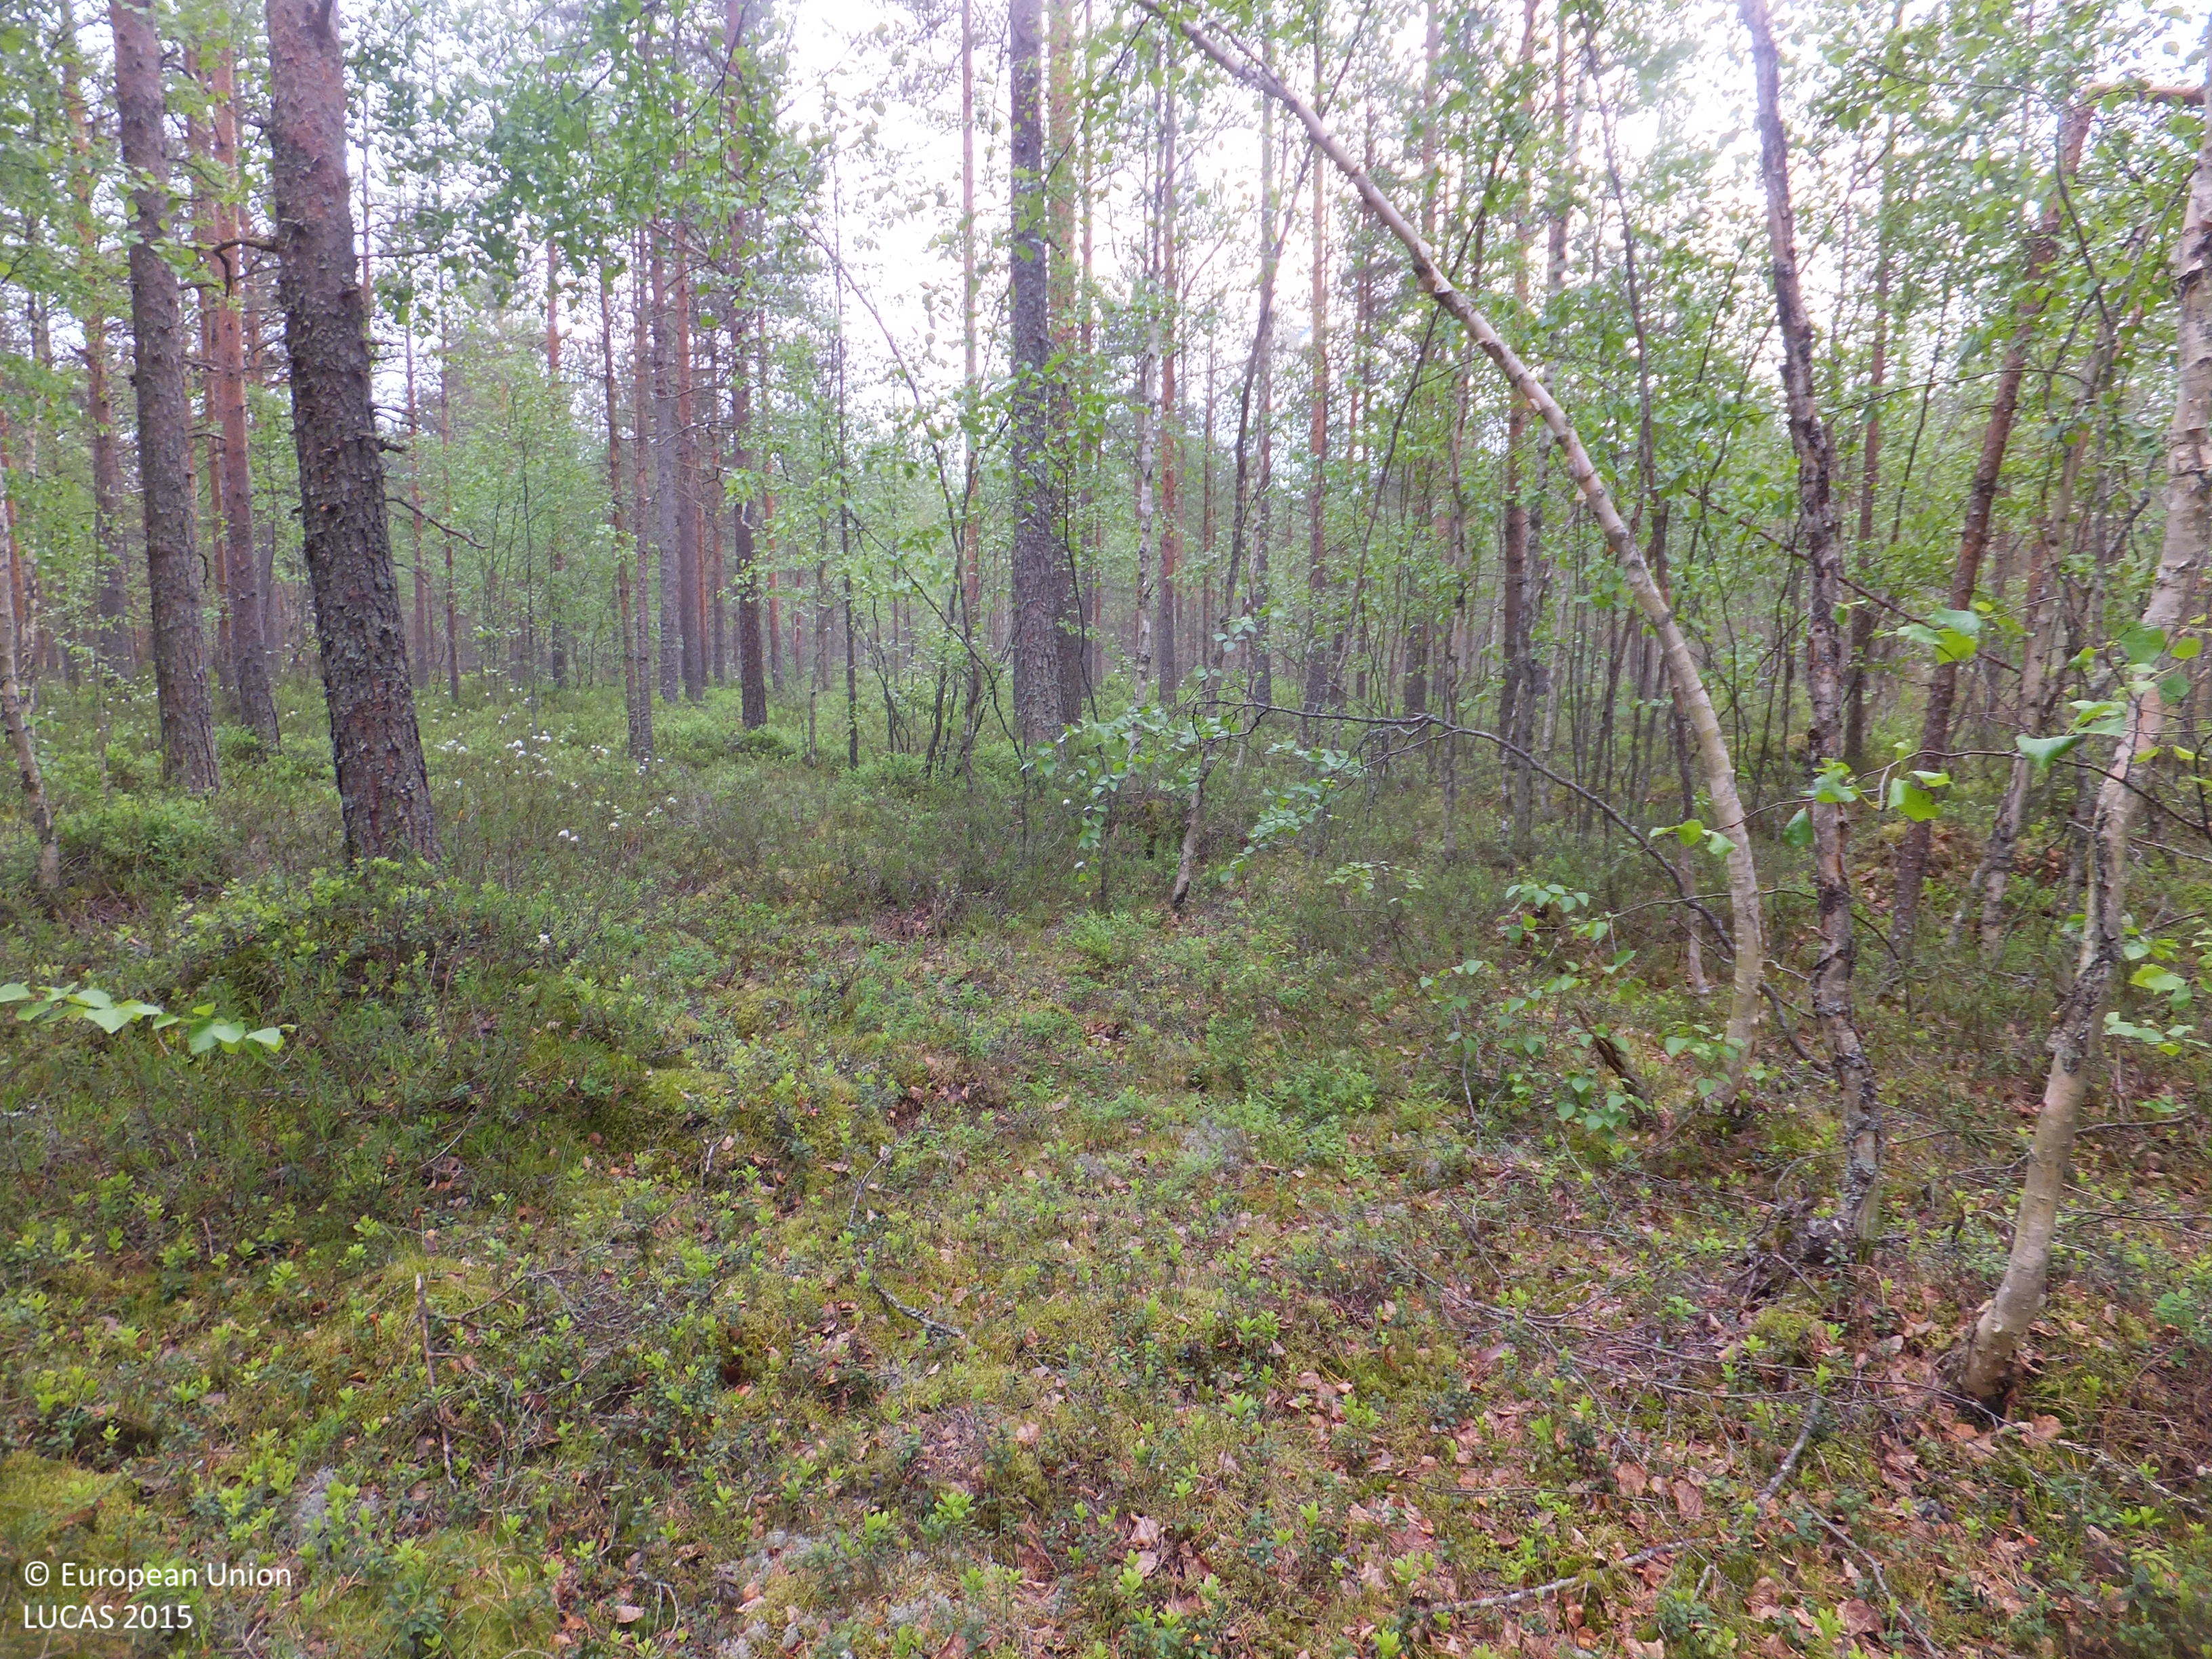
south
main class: Woodland
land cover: Pine dominated mixed woodland
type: boreal forest
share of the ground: > 75 %
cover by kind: coniferous forest trees 45 %, broadleaved forest trees 25 %, shrubs 20 %, lichens and mosses 10 %
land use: Forestry
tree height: > 5 m
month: June
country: FI
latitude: 63.5265
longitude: 24.0860
